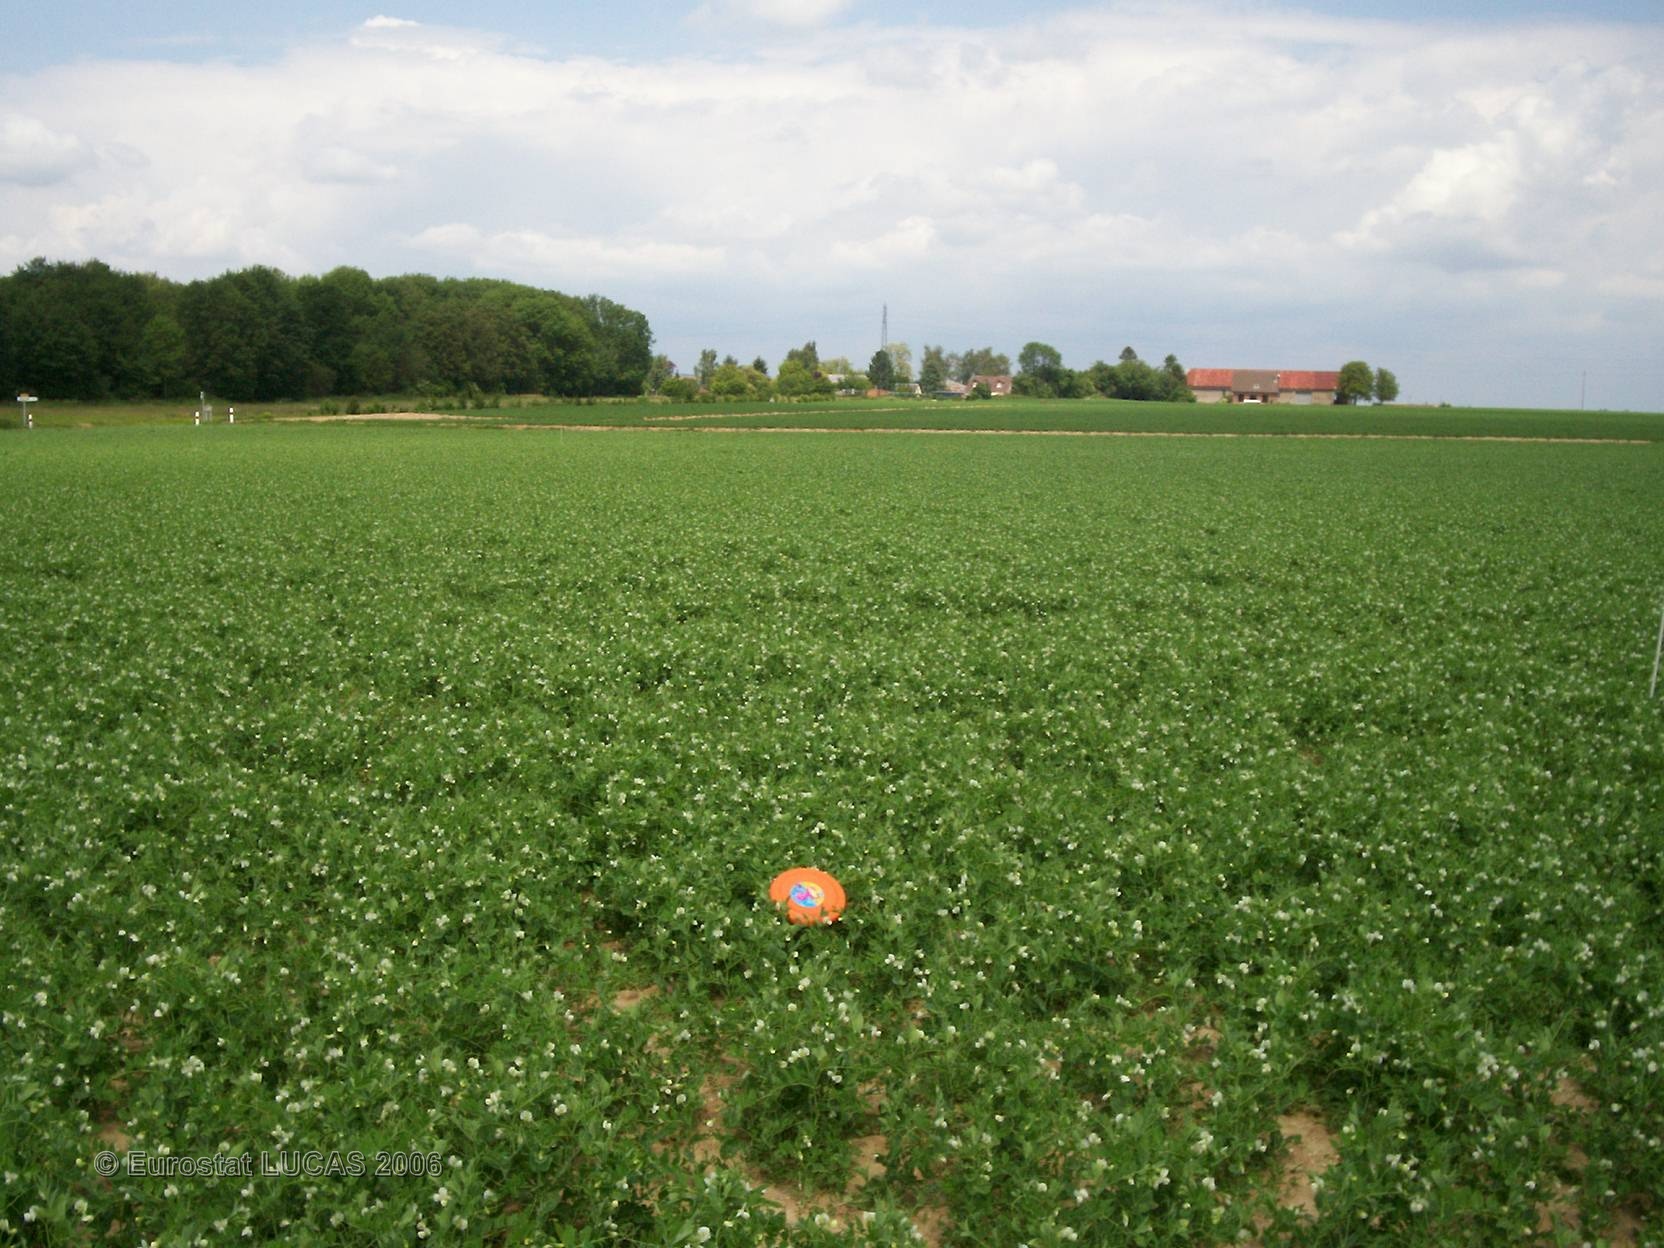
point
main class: Cropland
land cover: Dry pulses
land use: Agriculture (excluding fallow land and kitchen gardens)
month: June
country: FR
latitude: 49.7105
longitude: 2.6247
